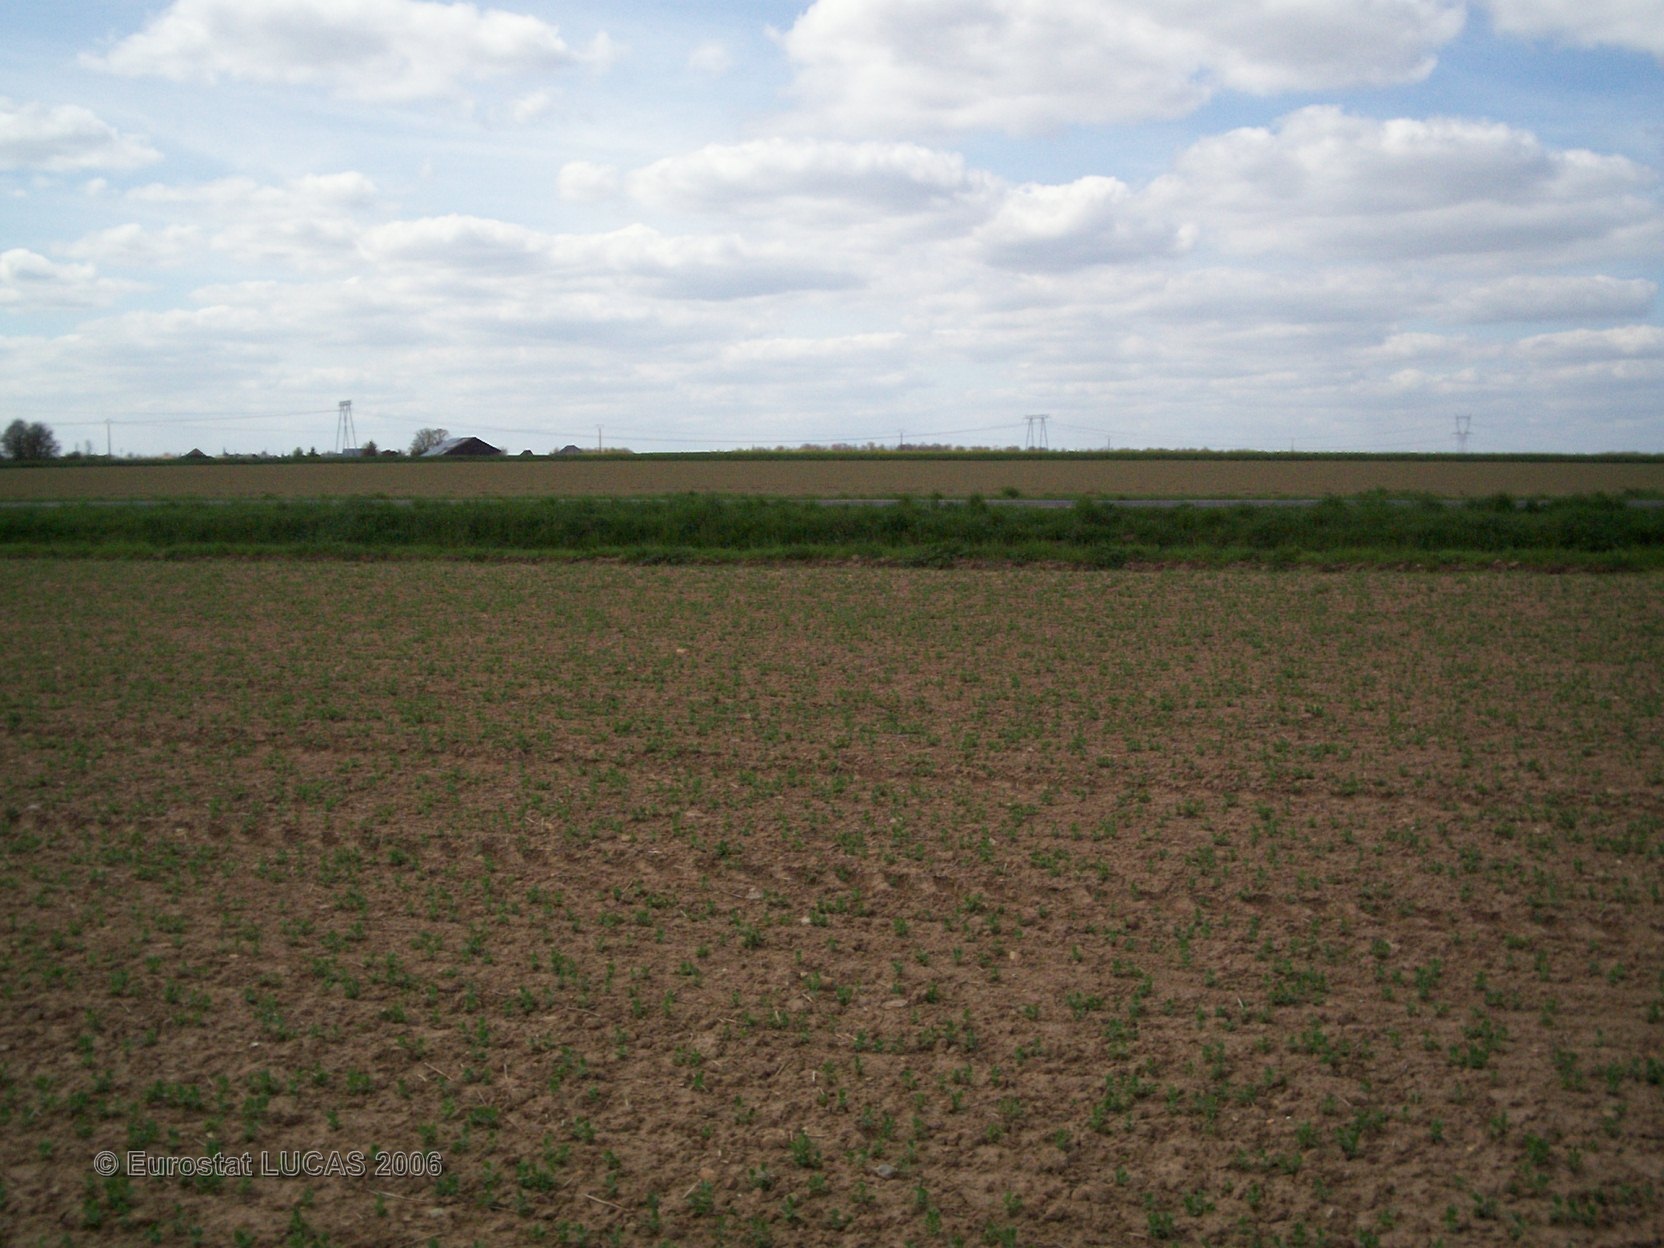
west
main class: Cropland
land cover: Dry pulses
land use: Agriculture (excluding fallow land and kitchen gardens)
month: April
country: FR
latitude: 48.9260
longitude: 1.0390
